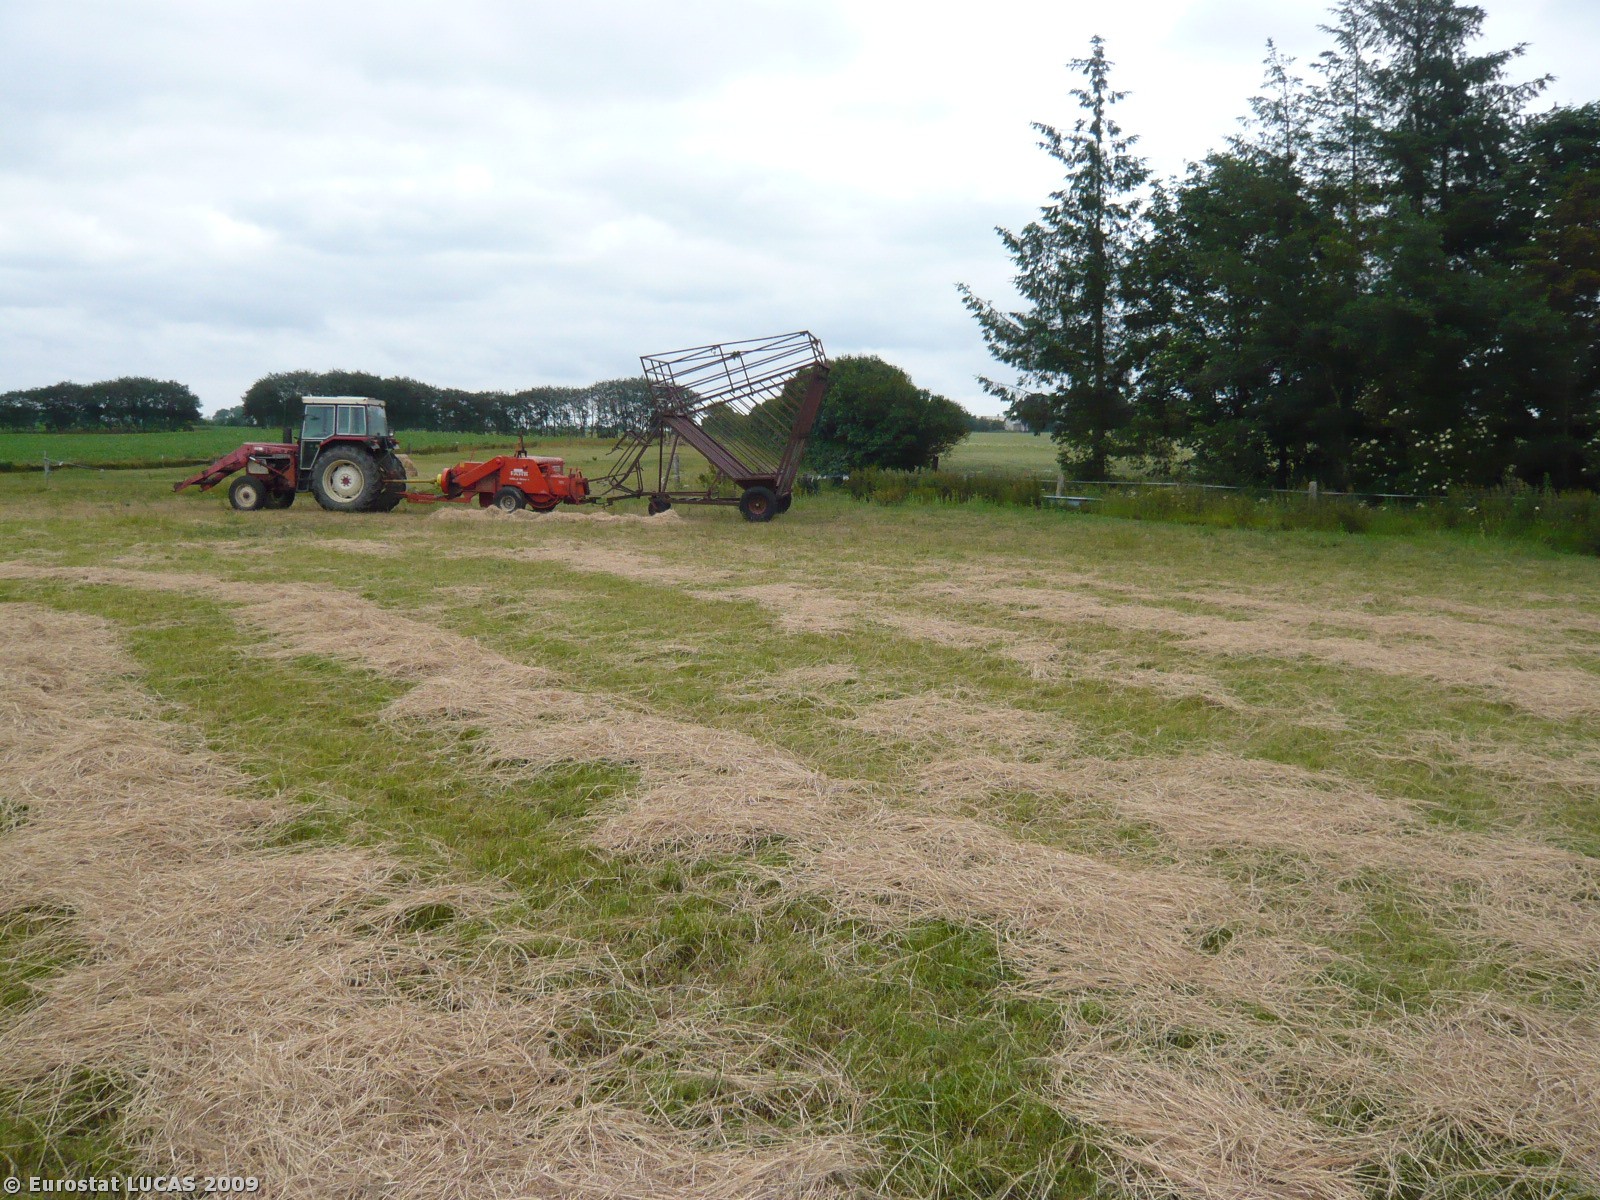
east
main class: Grassland
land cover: Grassland without tree/shrub cover
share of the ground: > 75 %
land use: Agriculture (excluding fallow land and kitchen gardens)
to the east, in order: Grassland without tree/shrub cover; Fences; Grassland without tree/shrub cover; Fences; Tracks; Broadleaved woodland; Dry stone walls; Common wheat
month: June
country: DK
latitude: 55.2708
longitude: 10.2673
